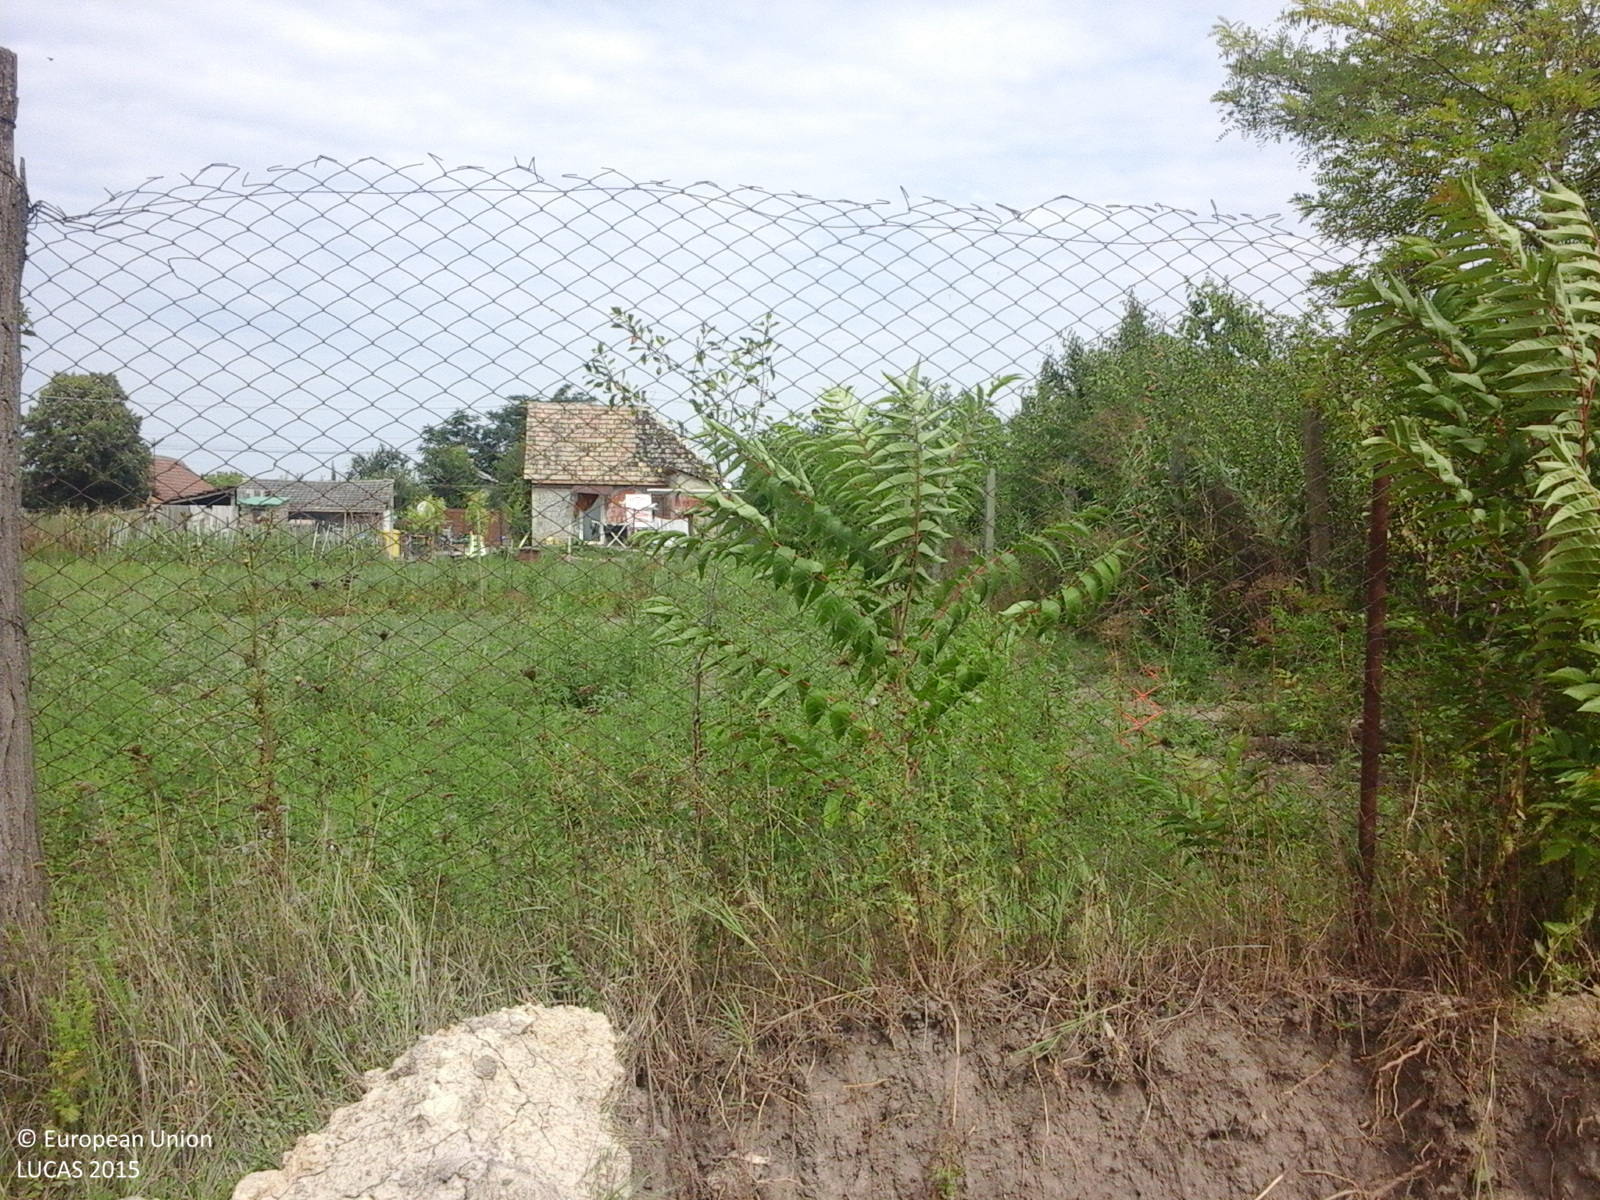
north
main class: Grassland
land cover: Spontaneously vegetated surfaces
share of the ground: > 75 %
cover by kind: herbaceous plants 100 %
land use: Fallow land
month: August
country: RO
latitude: 46.1544
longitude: 20.7357
